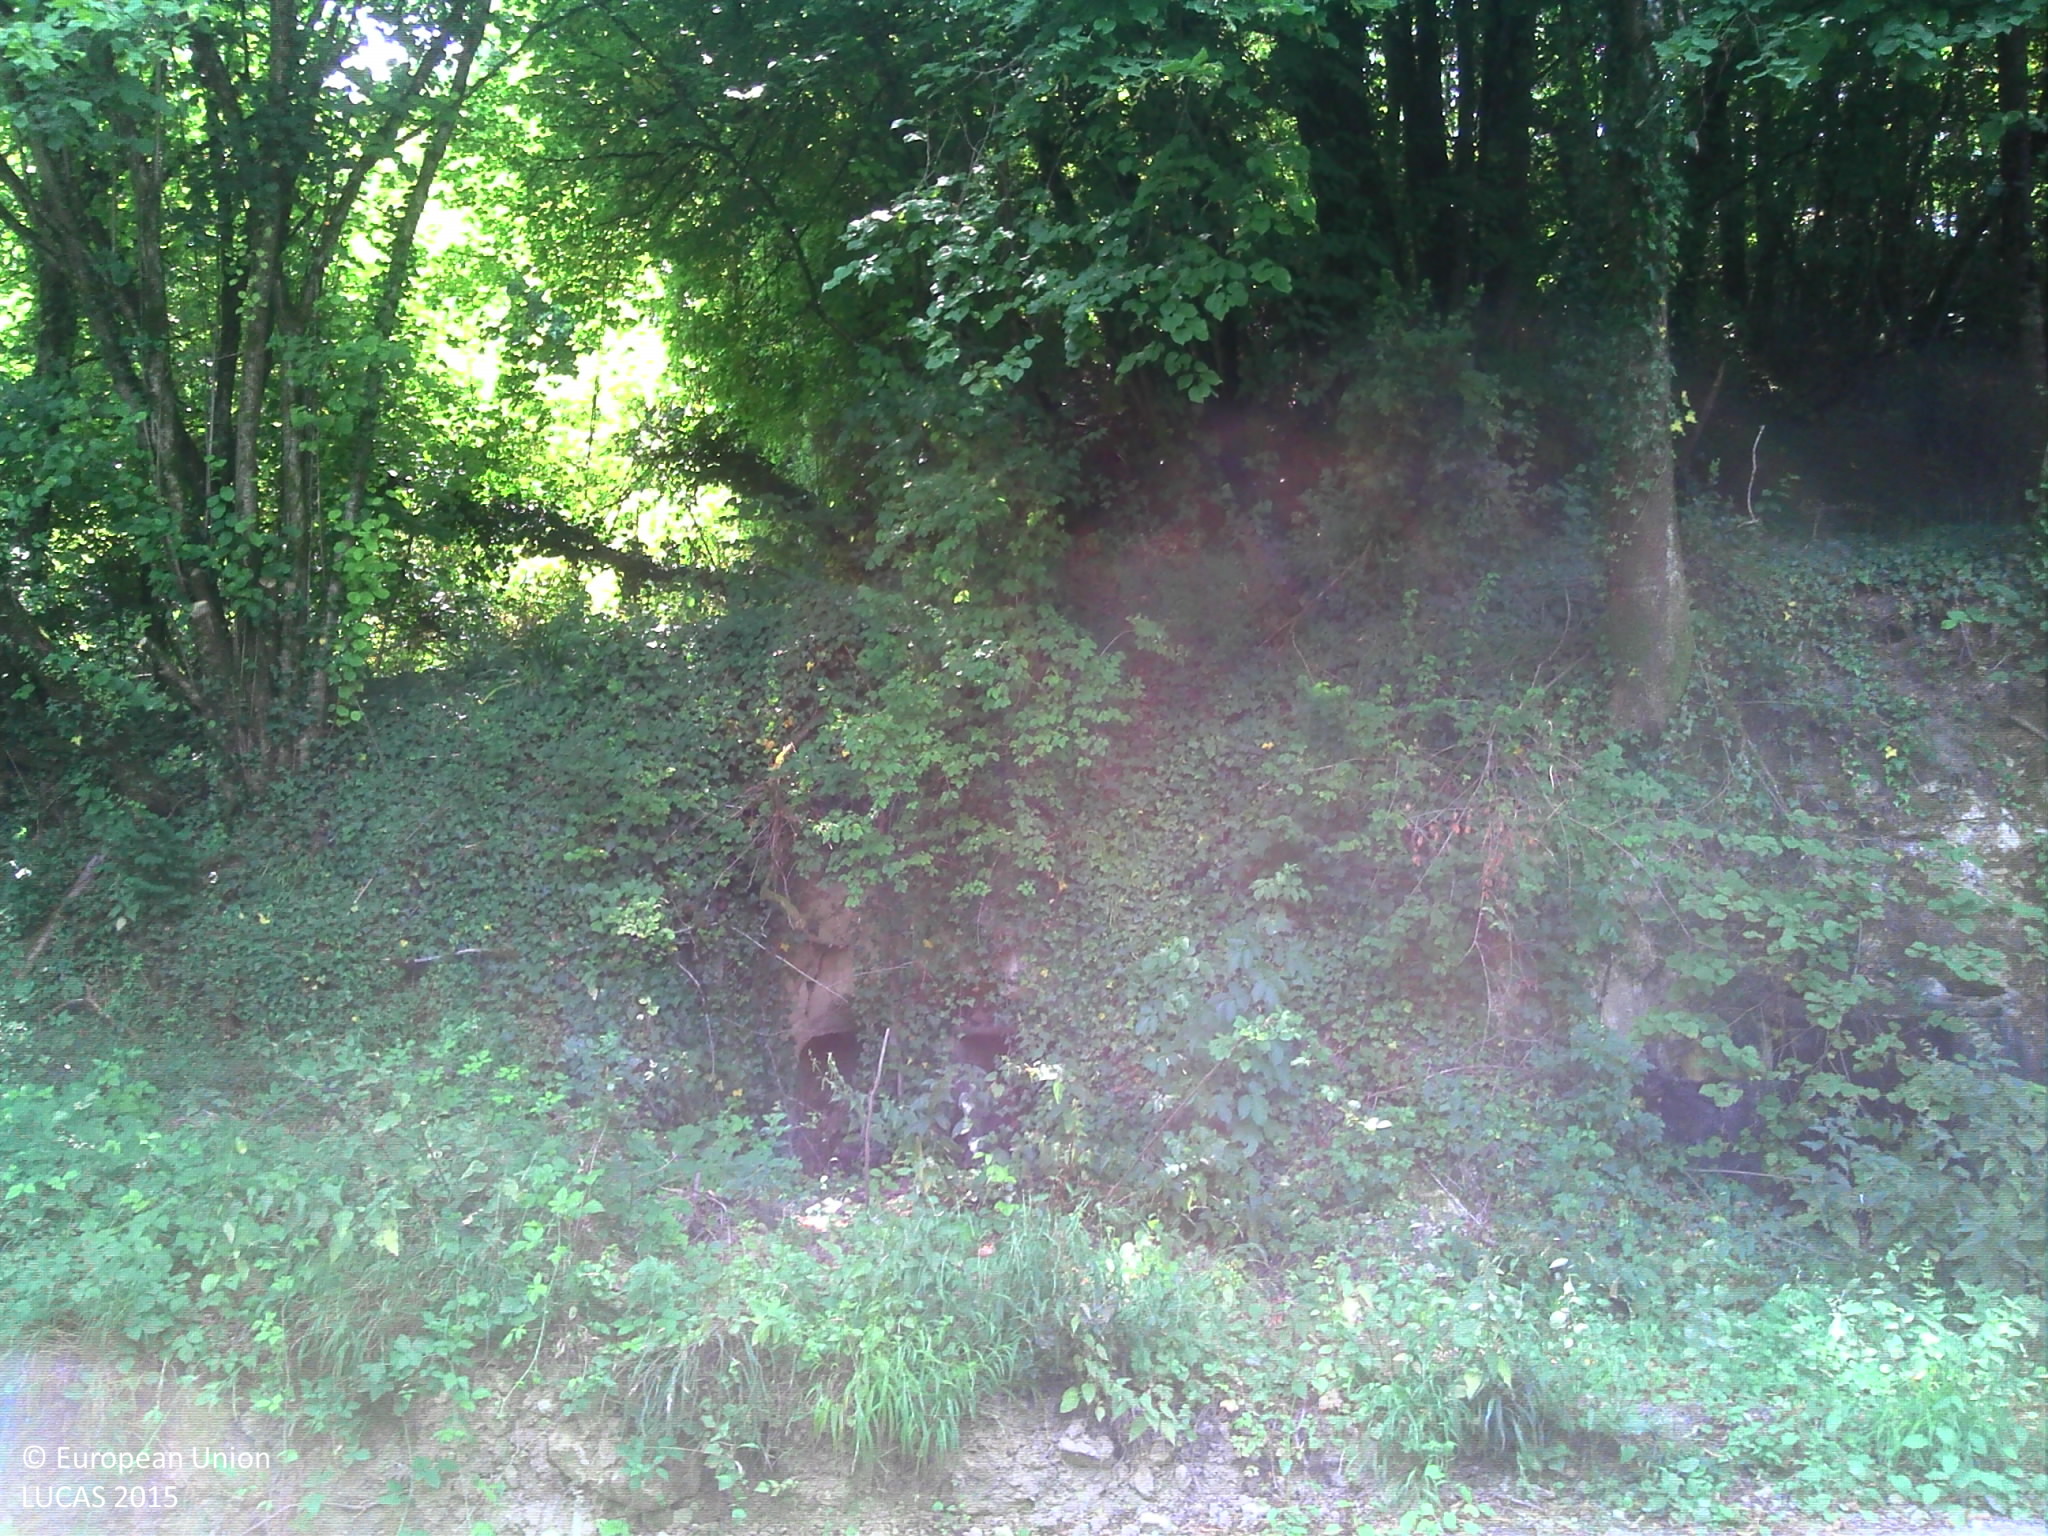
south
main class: Woodland
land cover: Broadleaved woodland
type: mesophytic deciduous forest
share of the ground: > 75 %
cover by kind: broadleaved forest trees 60 %, shrubs 25 %, herbaceous plants 10 %, lichens and mosses 5 %
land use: Forestry
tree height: > 5 m
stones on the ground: 10 - 25 %
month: August
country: FR
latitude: 47.1649
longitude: 0.1490
